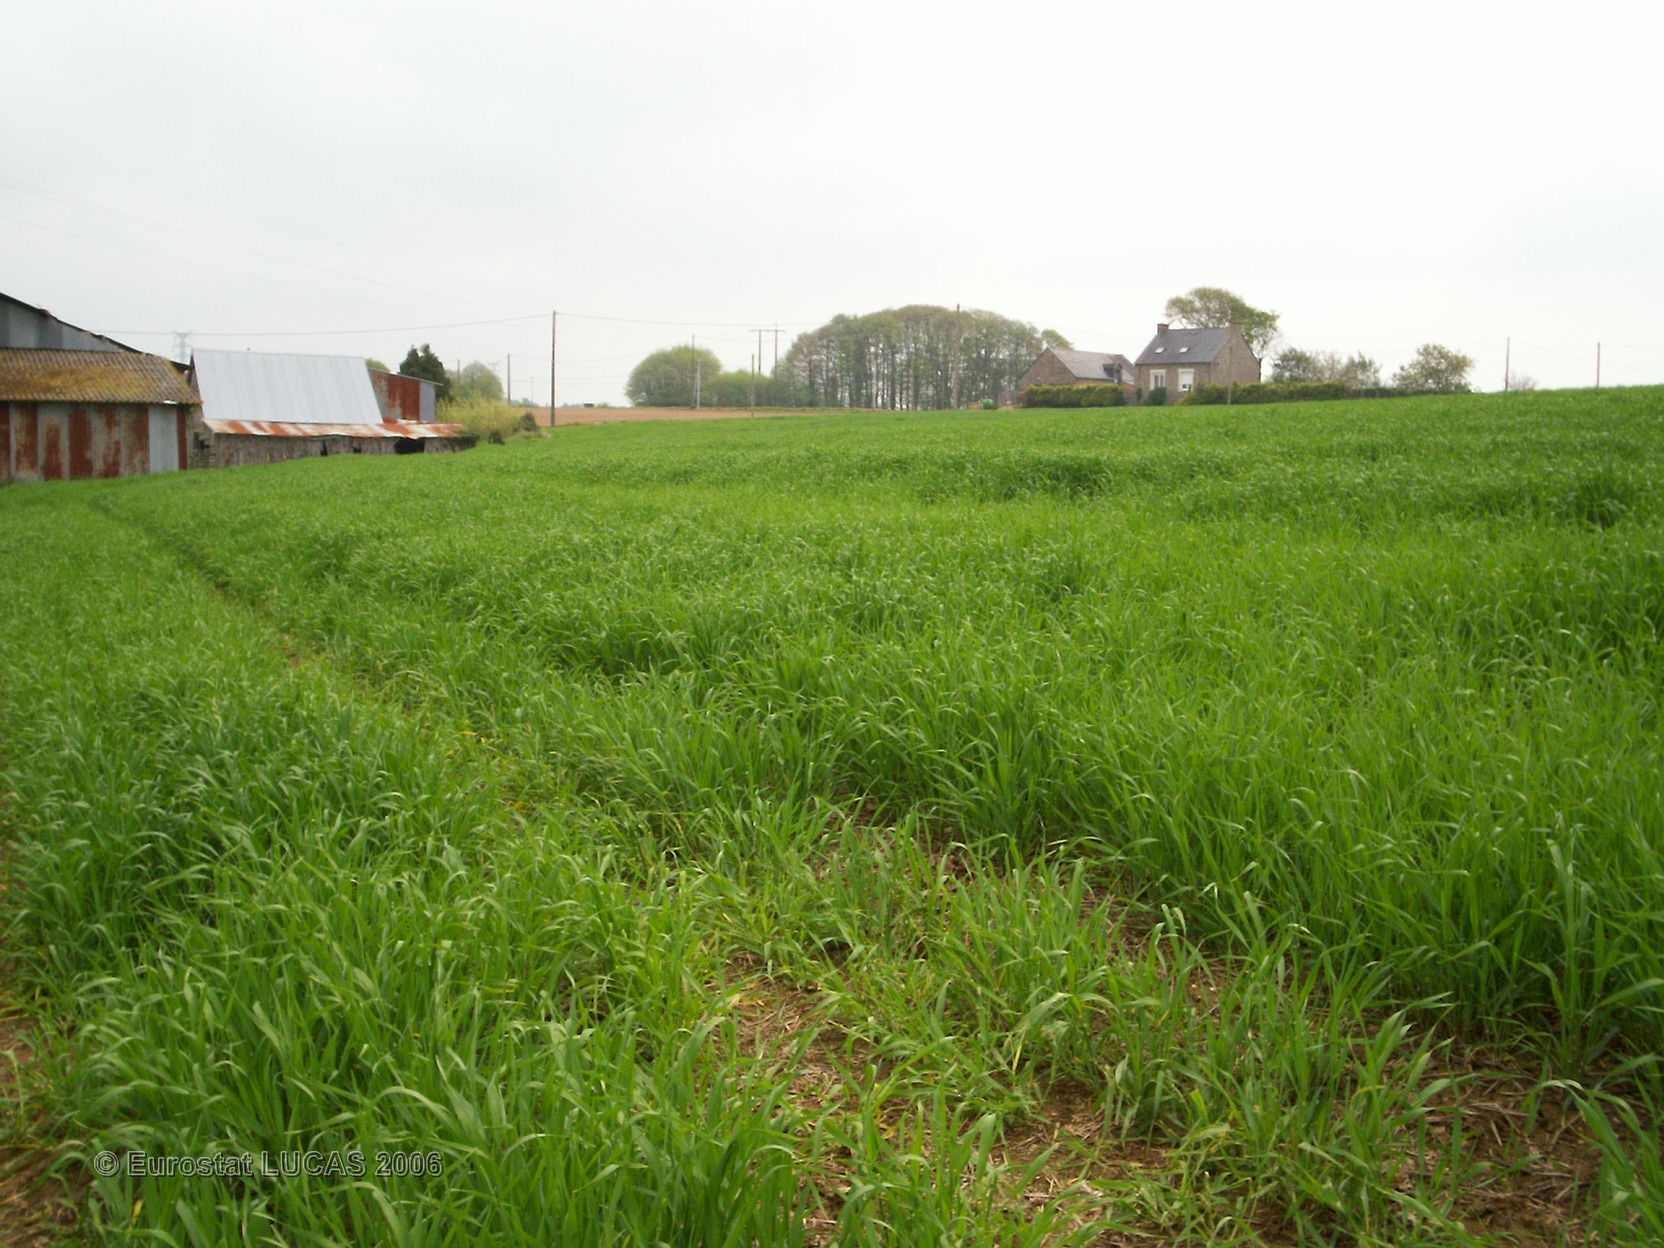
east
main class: Cropland
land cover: Barley
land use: Agriculture (excluding fallow land and kitchen gardens)
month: May
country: FR
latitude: 48.1661
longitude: -2.7982
